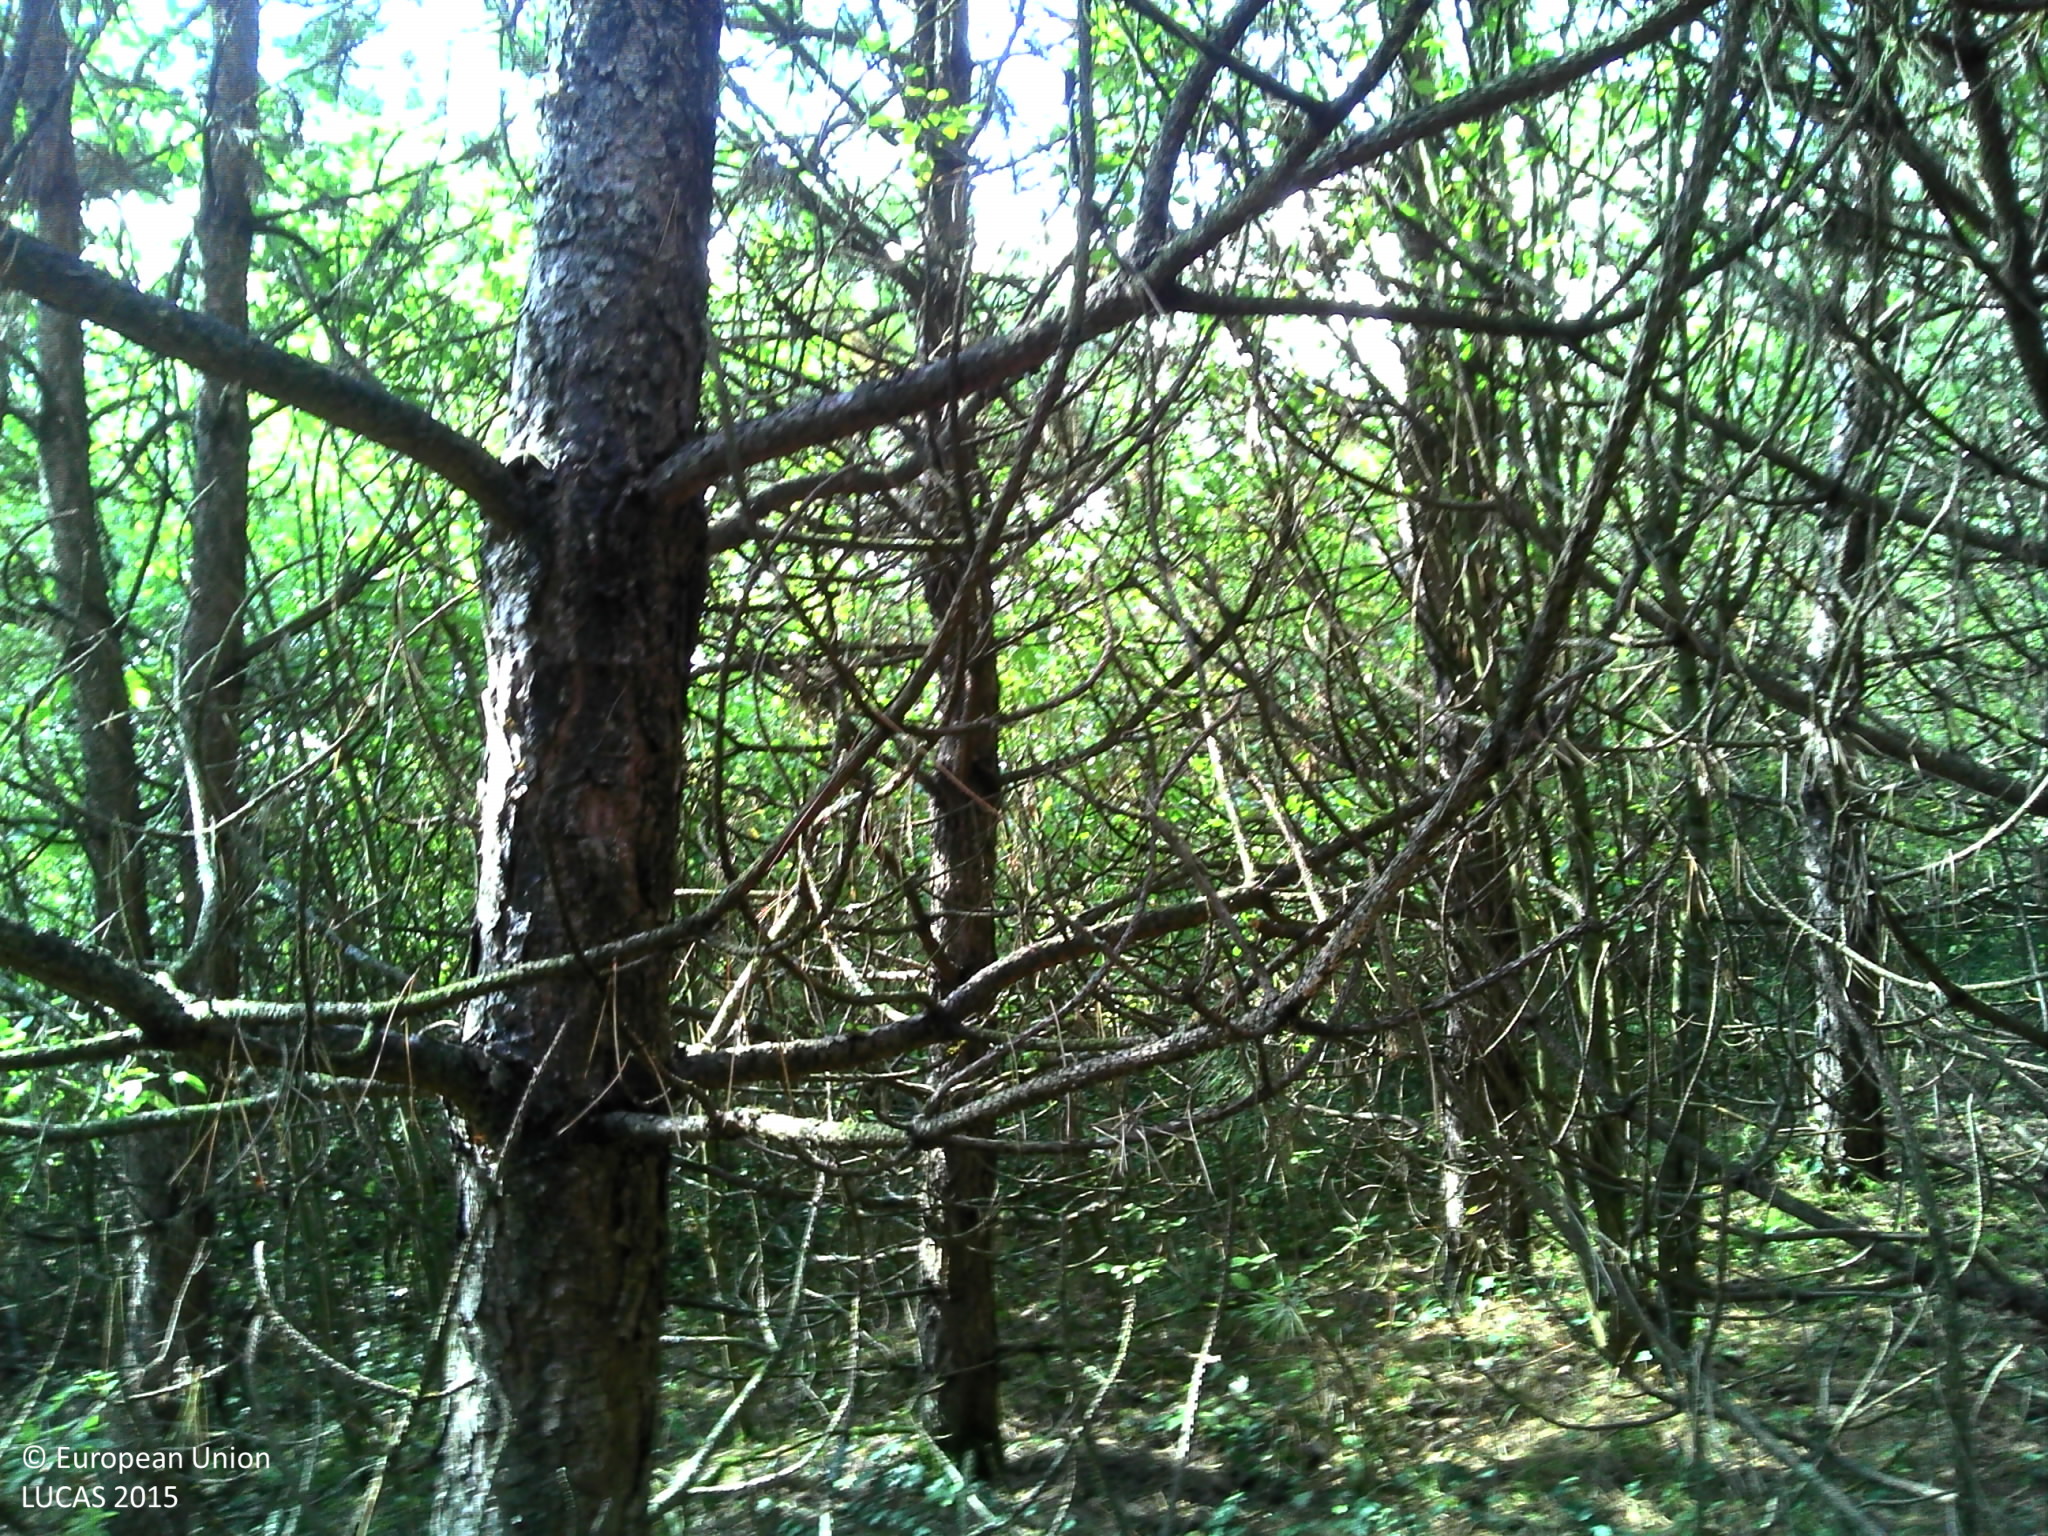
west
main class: Woodland
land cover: Pine dominated coniferous woodland
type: exotic forest
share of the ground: > 75 %
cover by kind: coniferous forest trees 100 %
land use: Forestry
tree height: > 5 m
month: September
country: FR
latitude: 48.3240
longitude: 4.2107
